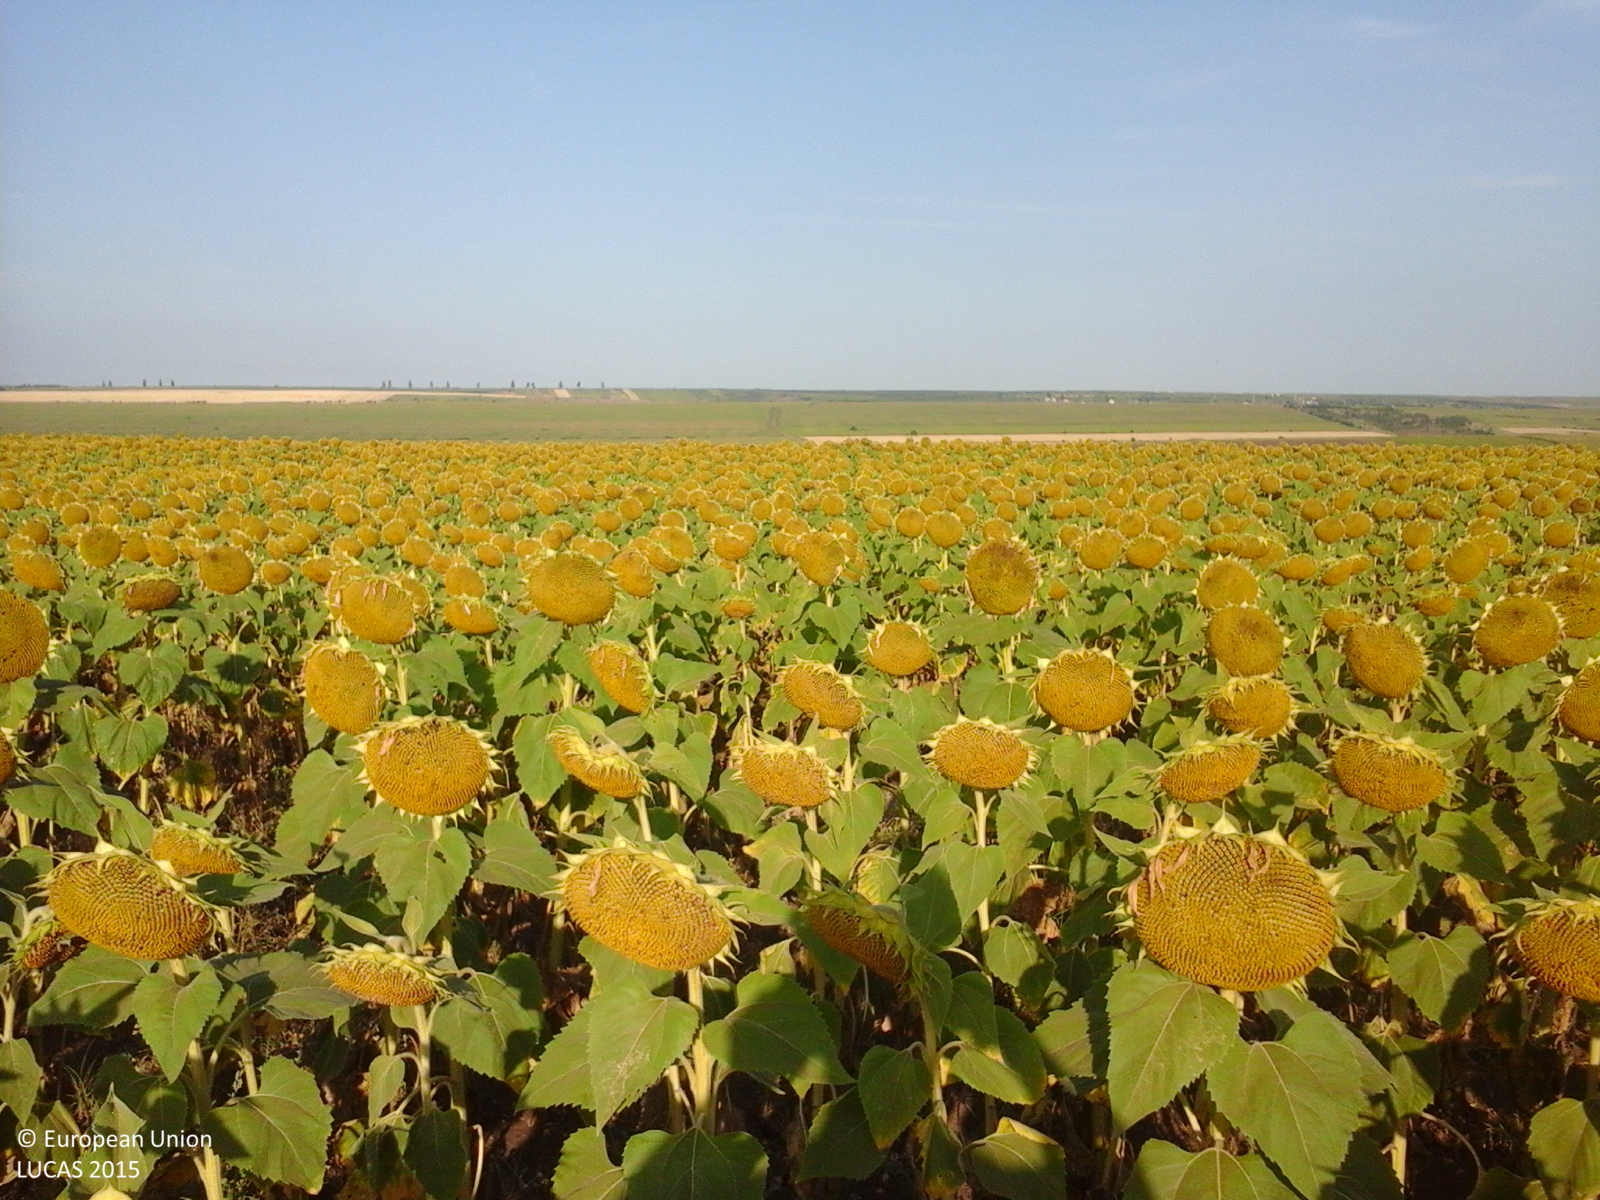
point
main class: Cropland
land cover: Sunflower
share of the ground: > 75 %
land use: Agriculture (excluding fallow land and kitchen gardens)
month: July
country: RO
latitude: 45.9654
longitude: 27.8077
